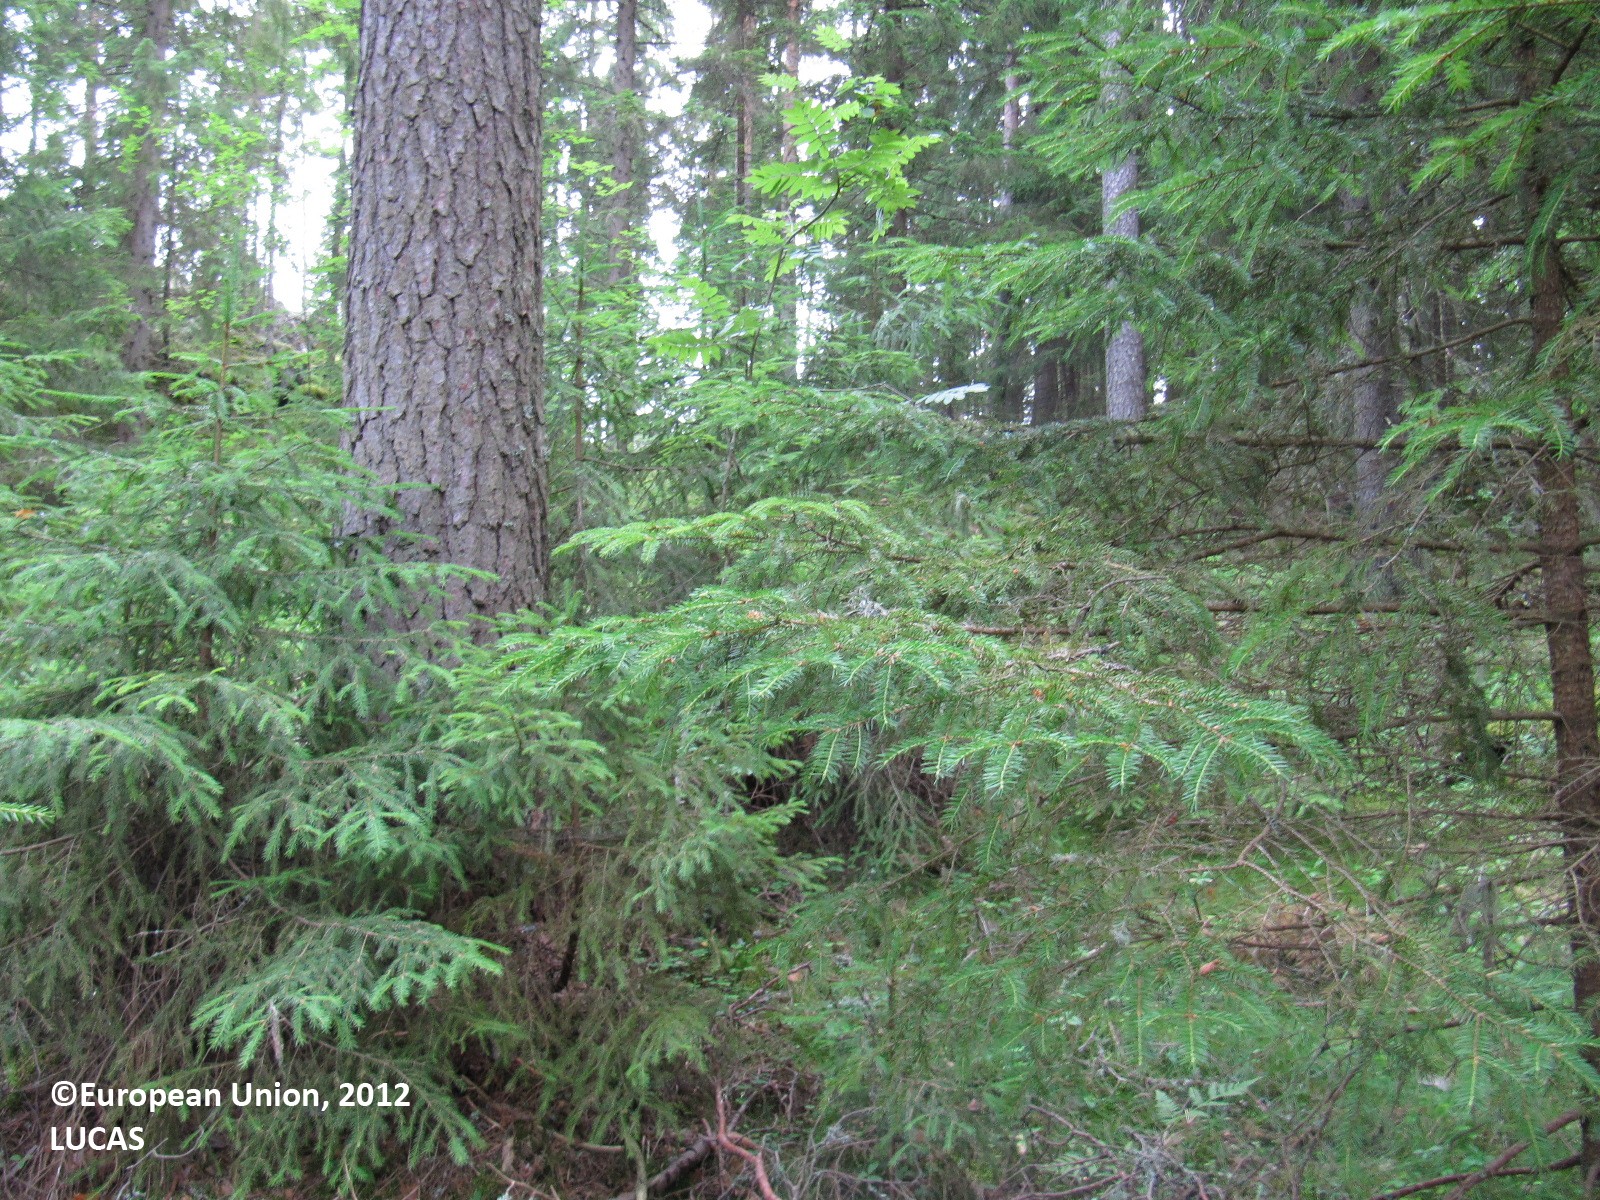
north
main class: Woodland
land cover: Spruce dominated coniferous woodland
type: boreal forest
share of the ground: 50 - 75 %
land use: Forestry
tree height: > 5 m
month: July
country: FI
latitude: 60.8000
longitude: 23.4051
